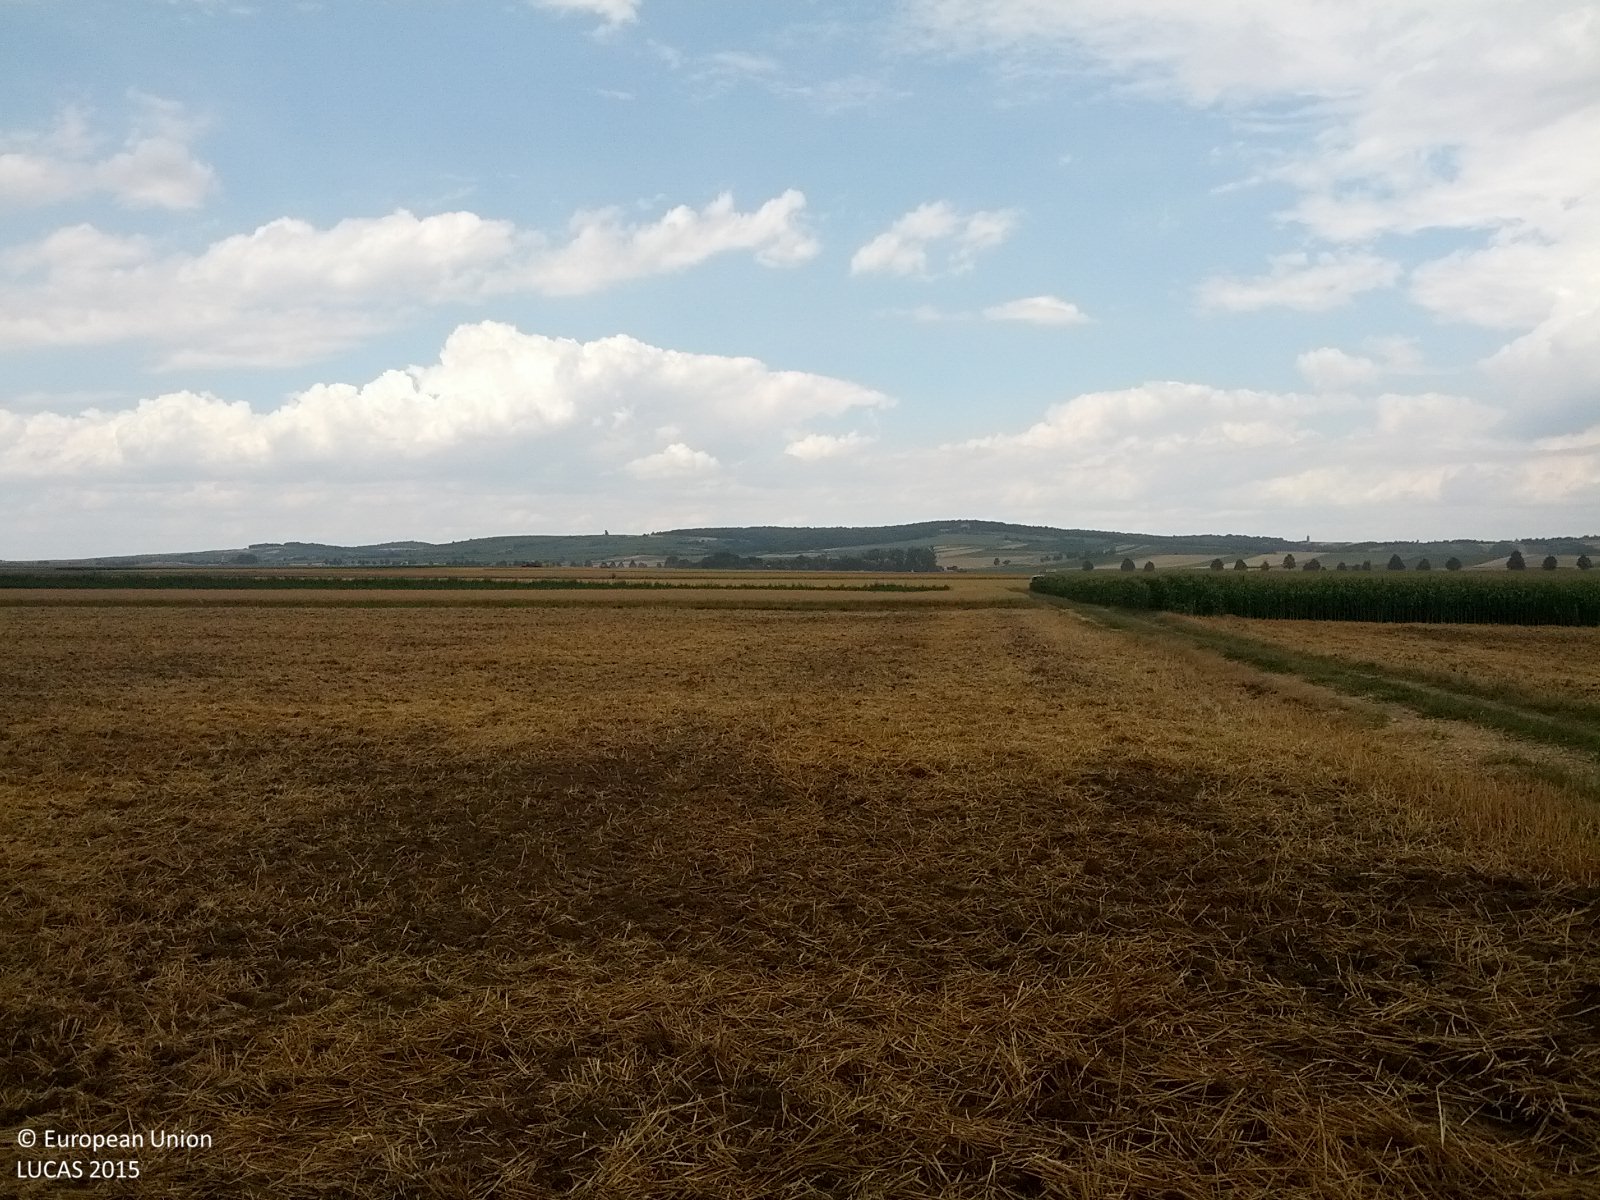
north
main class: Cropland
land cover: Sugar beet
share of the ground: > 75 %
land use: Agriculture (excluding fallow land and kitchen gardens)
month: July
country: AT
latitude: 48.4171
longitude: 16.0711
